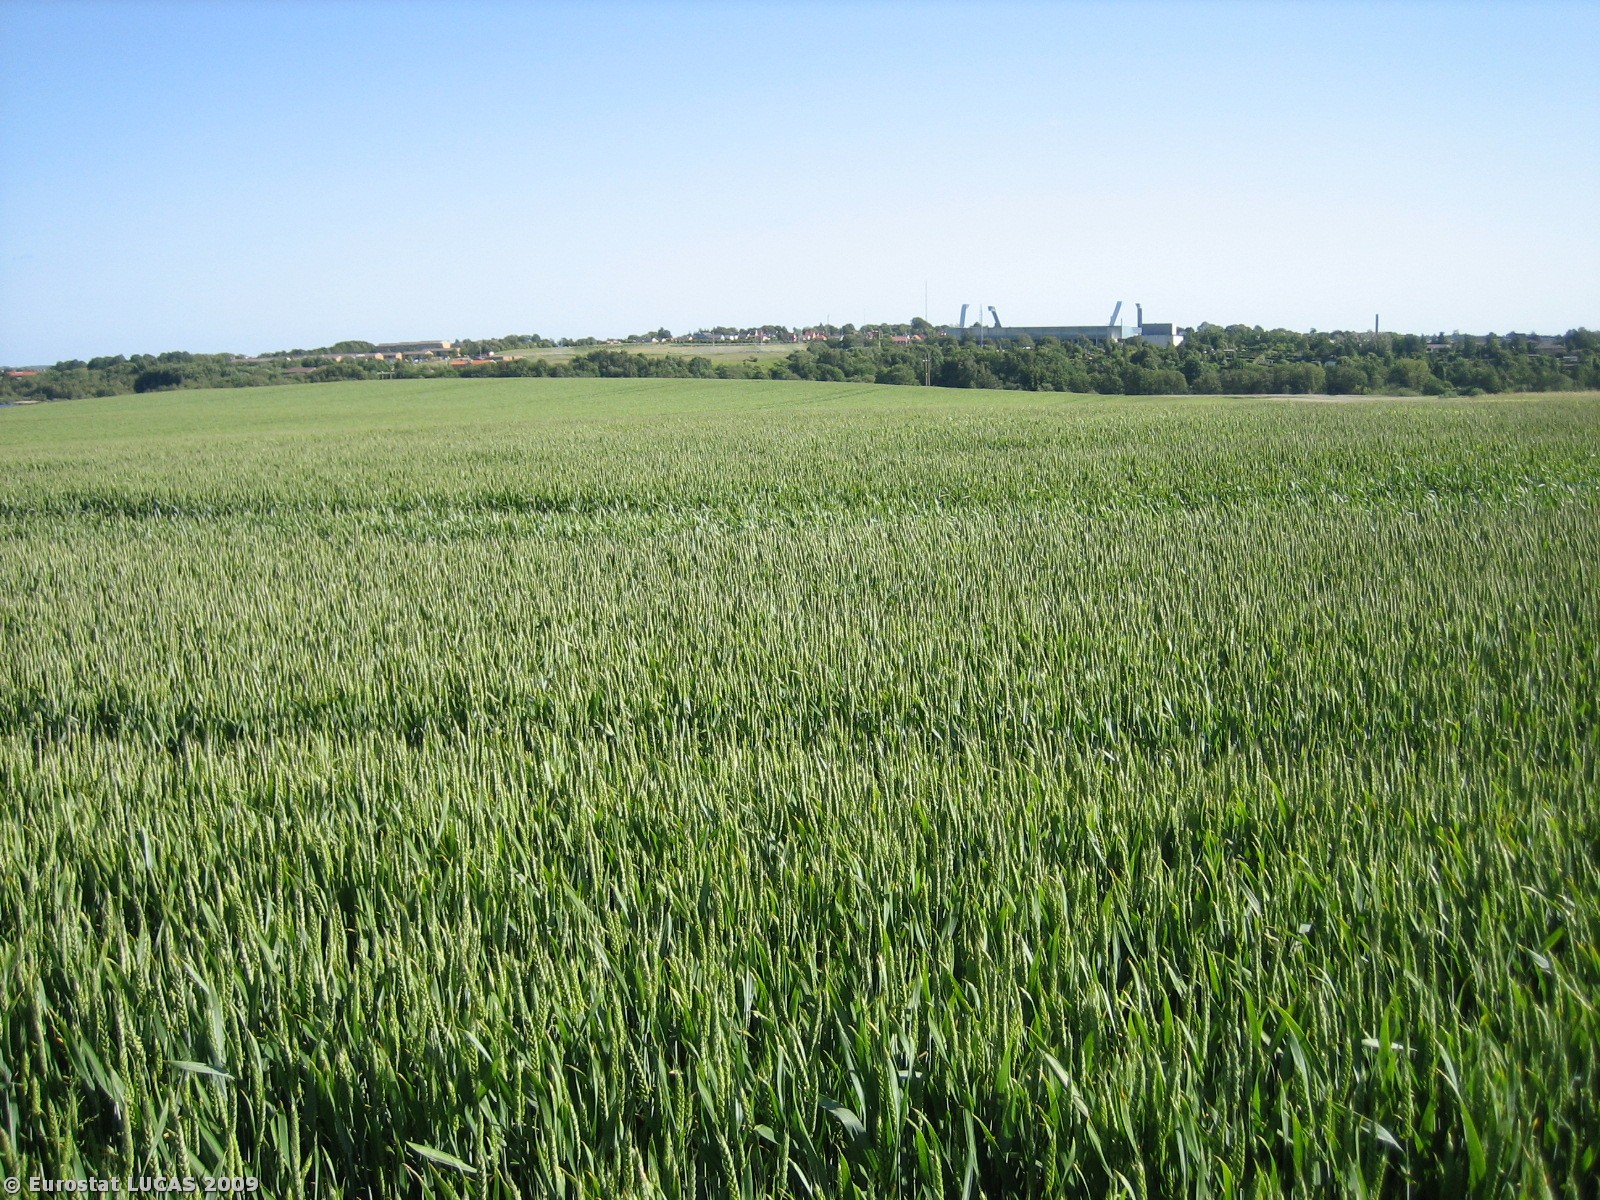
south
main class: Cropland
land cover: Common wheat
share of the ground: > 75 %
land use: Agriculture (excluding fallow land and kitchen gardens)
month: June
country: DK
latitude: 55.8821
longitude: 9.8563
